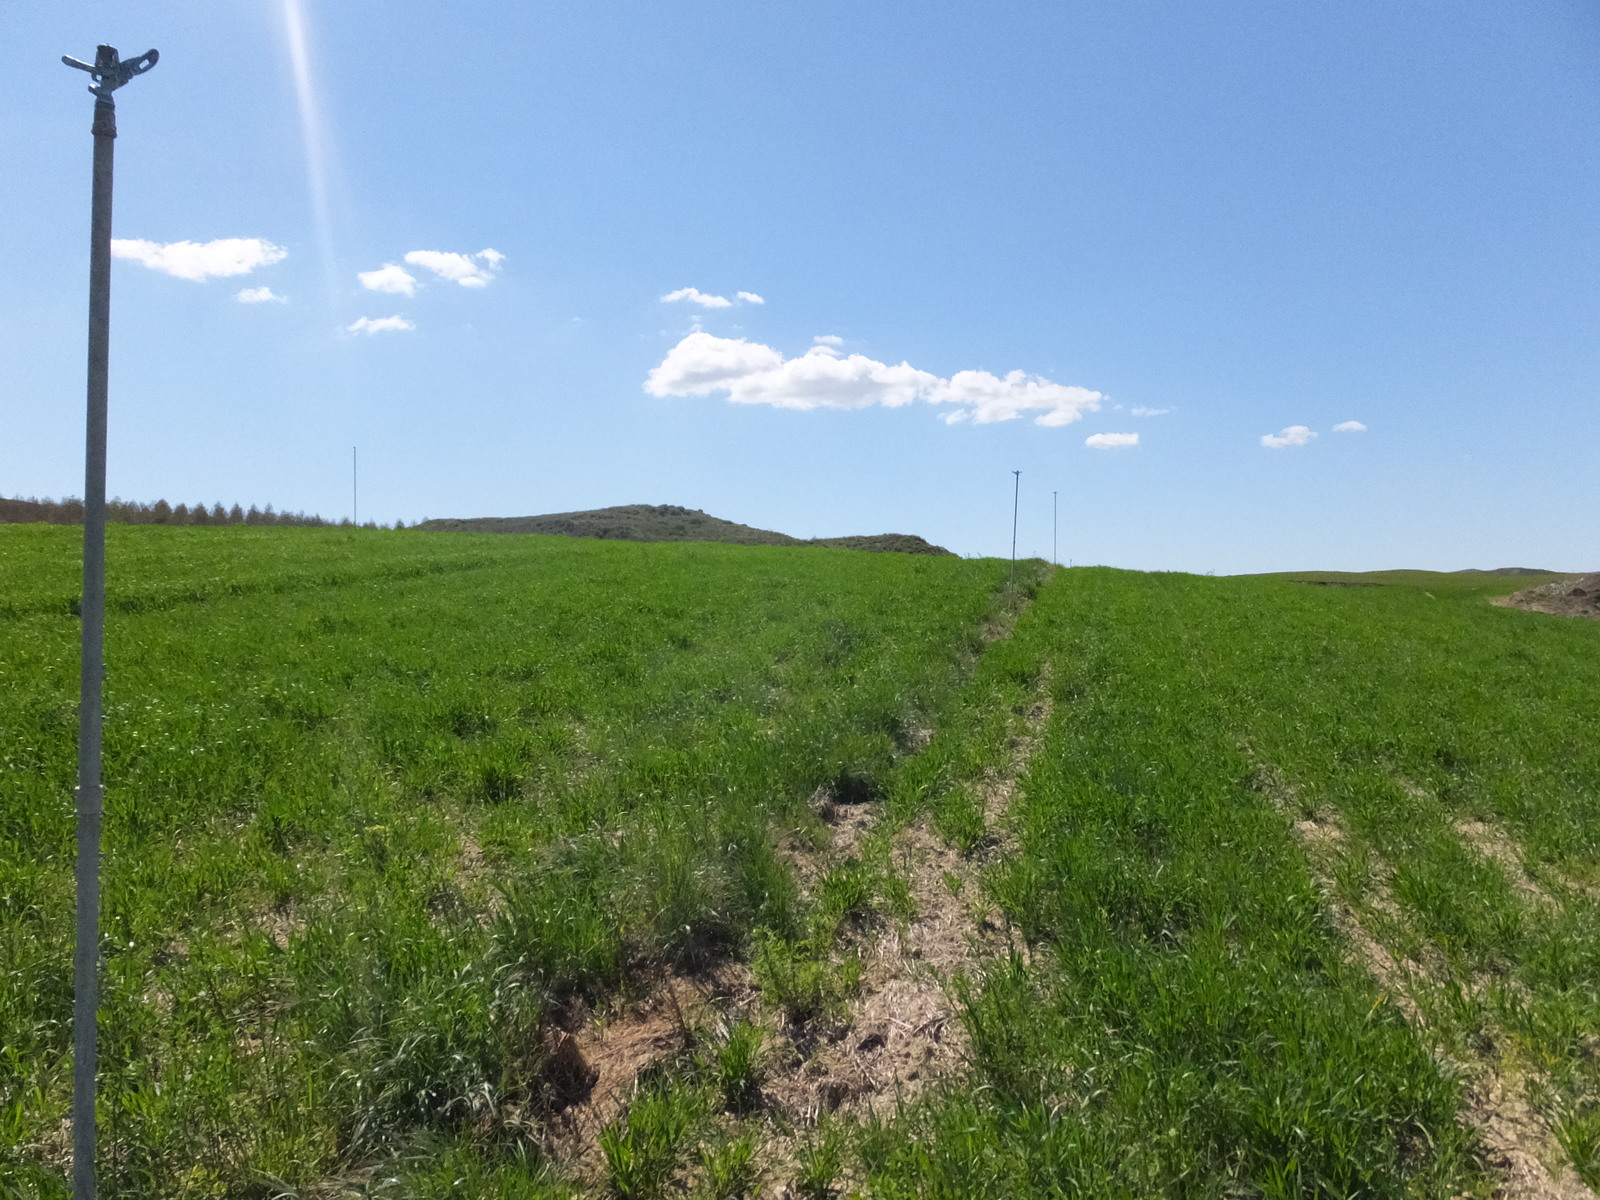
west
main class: Cropland
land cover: Durum wheat
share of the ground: > 75 %
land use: Agriculture (excluding fallow land and kitchen gardens)
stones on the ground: < 10 %
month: April
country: ES
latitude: 41.7122
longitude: -0.2700
